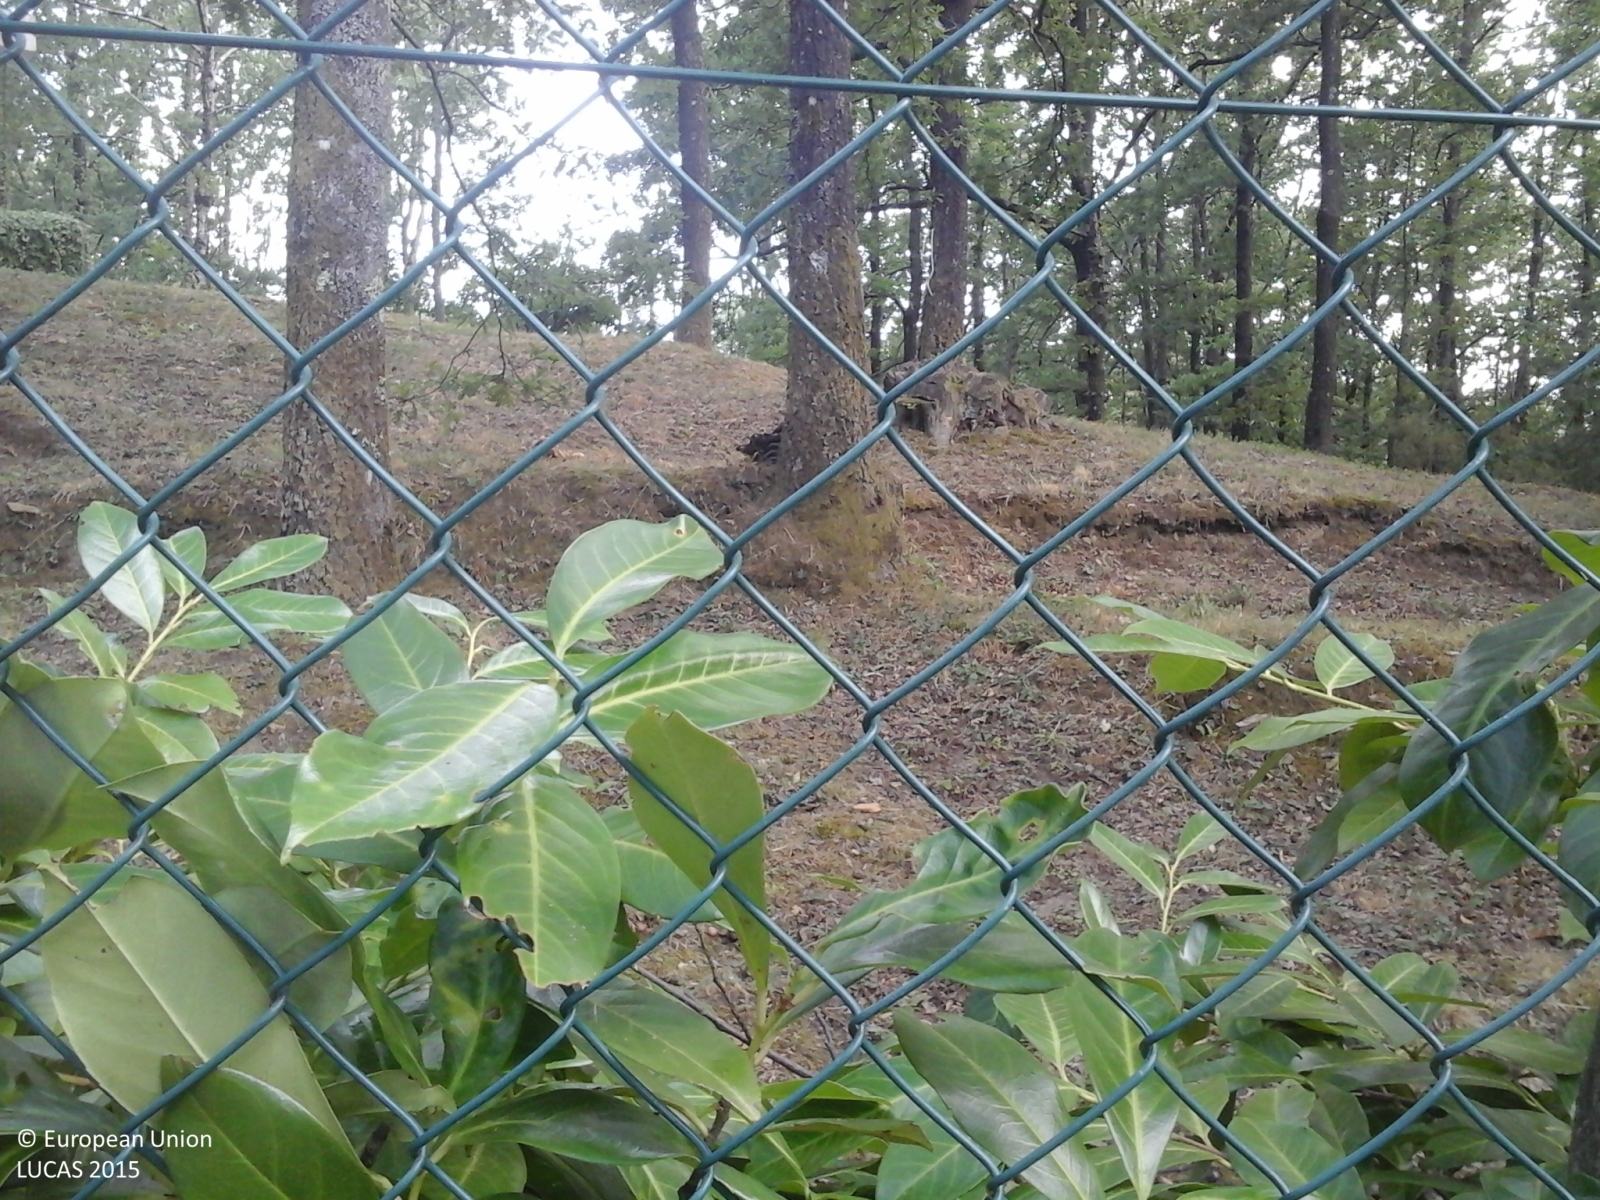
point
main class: Woodland
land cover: Broadleaved woodland
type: thermophilous deciduous forest
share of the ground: > 75 %
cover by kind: broadleaved forest trees 95 %, herbaceous plants 5 %
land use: Amenities, museums, leisure
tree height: > 5 m
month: August
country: IT
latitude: 43.9339
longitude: 10.6088
